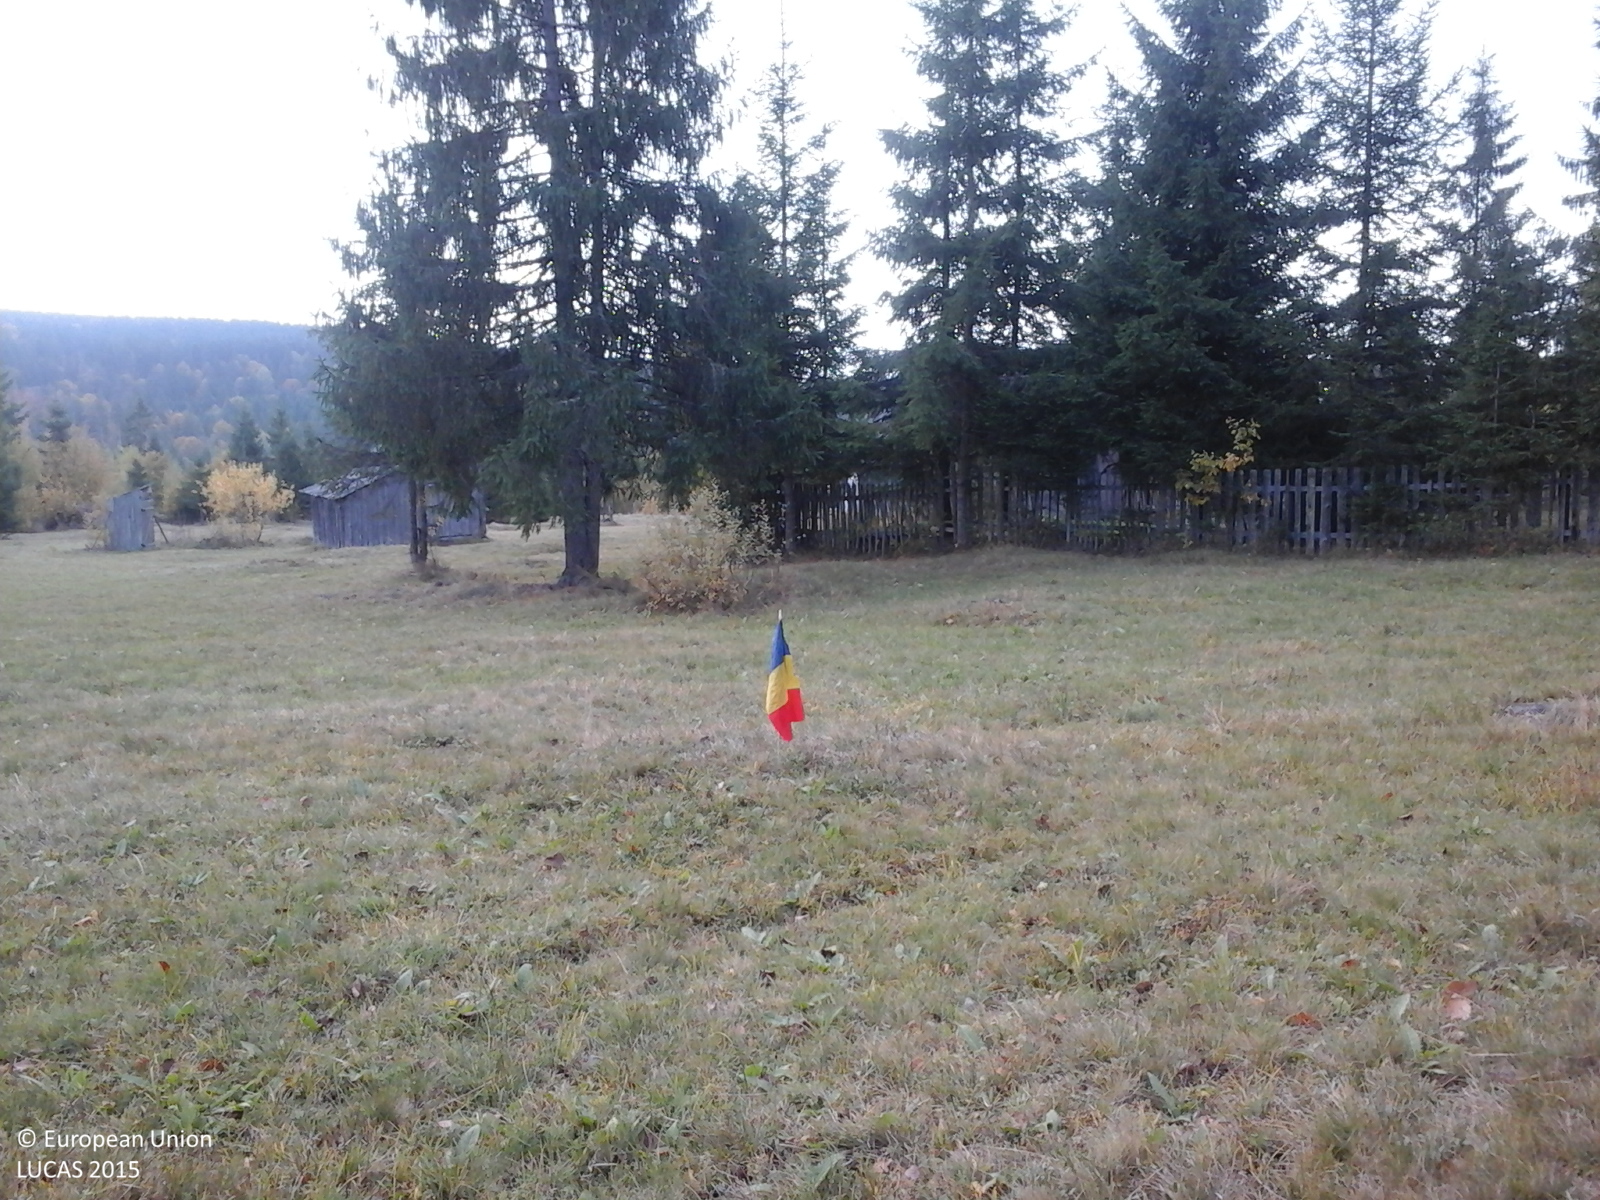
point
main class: Grassland
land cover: Grassland without tree/shrub cover
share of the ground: > 75 %
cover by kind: herbaceous plants 100 %
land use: Agriculture (excluding fallow land and kitchen gardens)
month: October
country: RO
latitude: 46.5488
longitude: 25.5120
